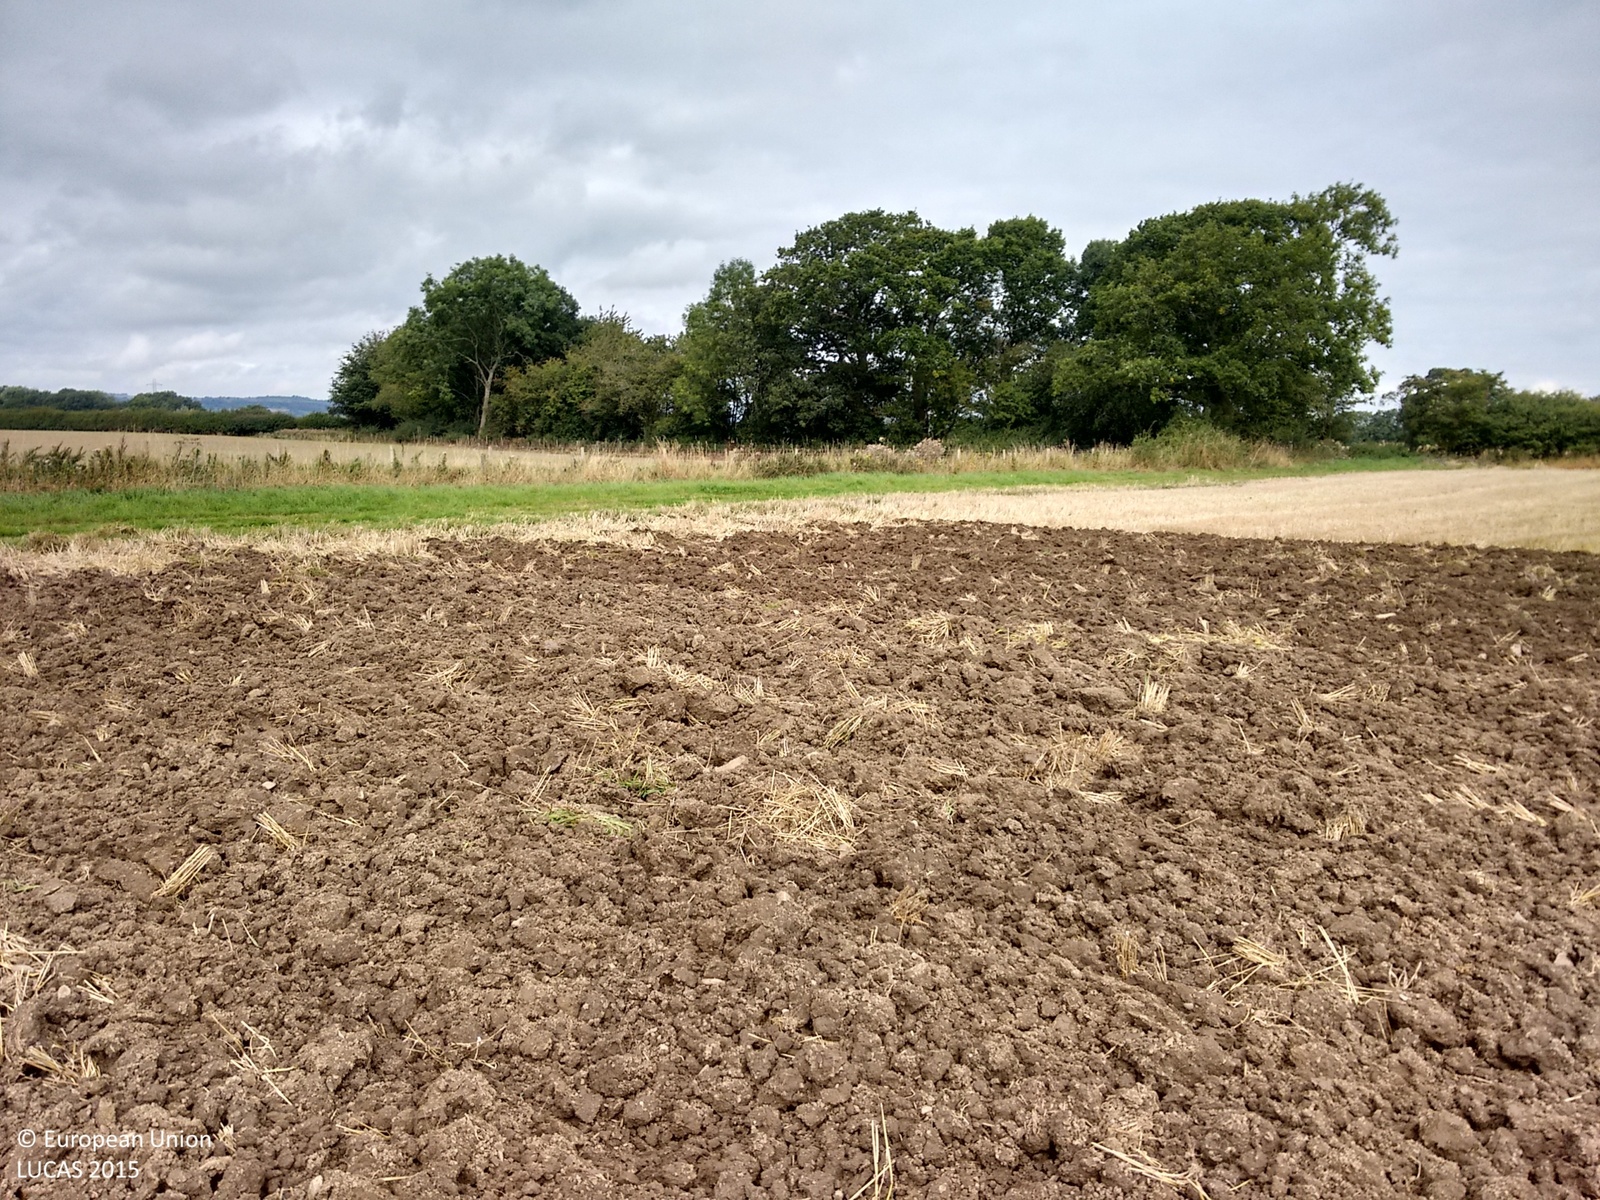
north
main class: Cropland
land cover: Barley
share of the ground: < 10 %
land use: Agriculture (excluding fallow land and kitchen gardens)
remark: Harvested field
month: September
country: GB
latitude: 52.8600
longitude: -3.0116
